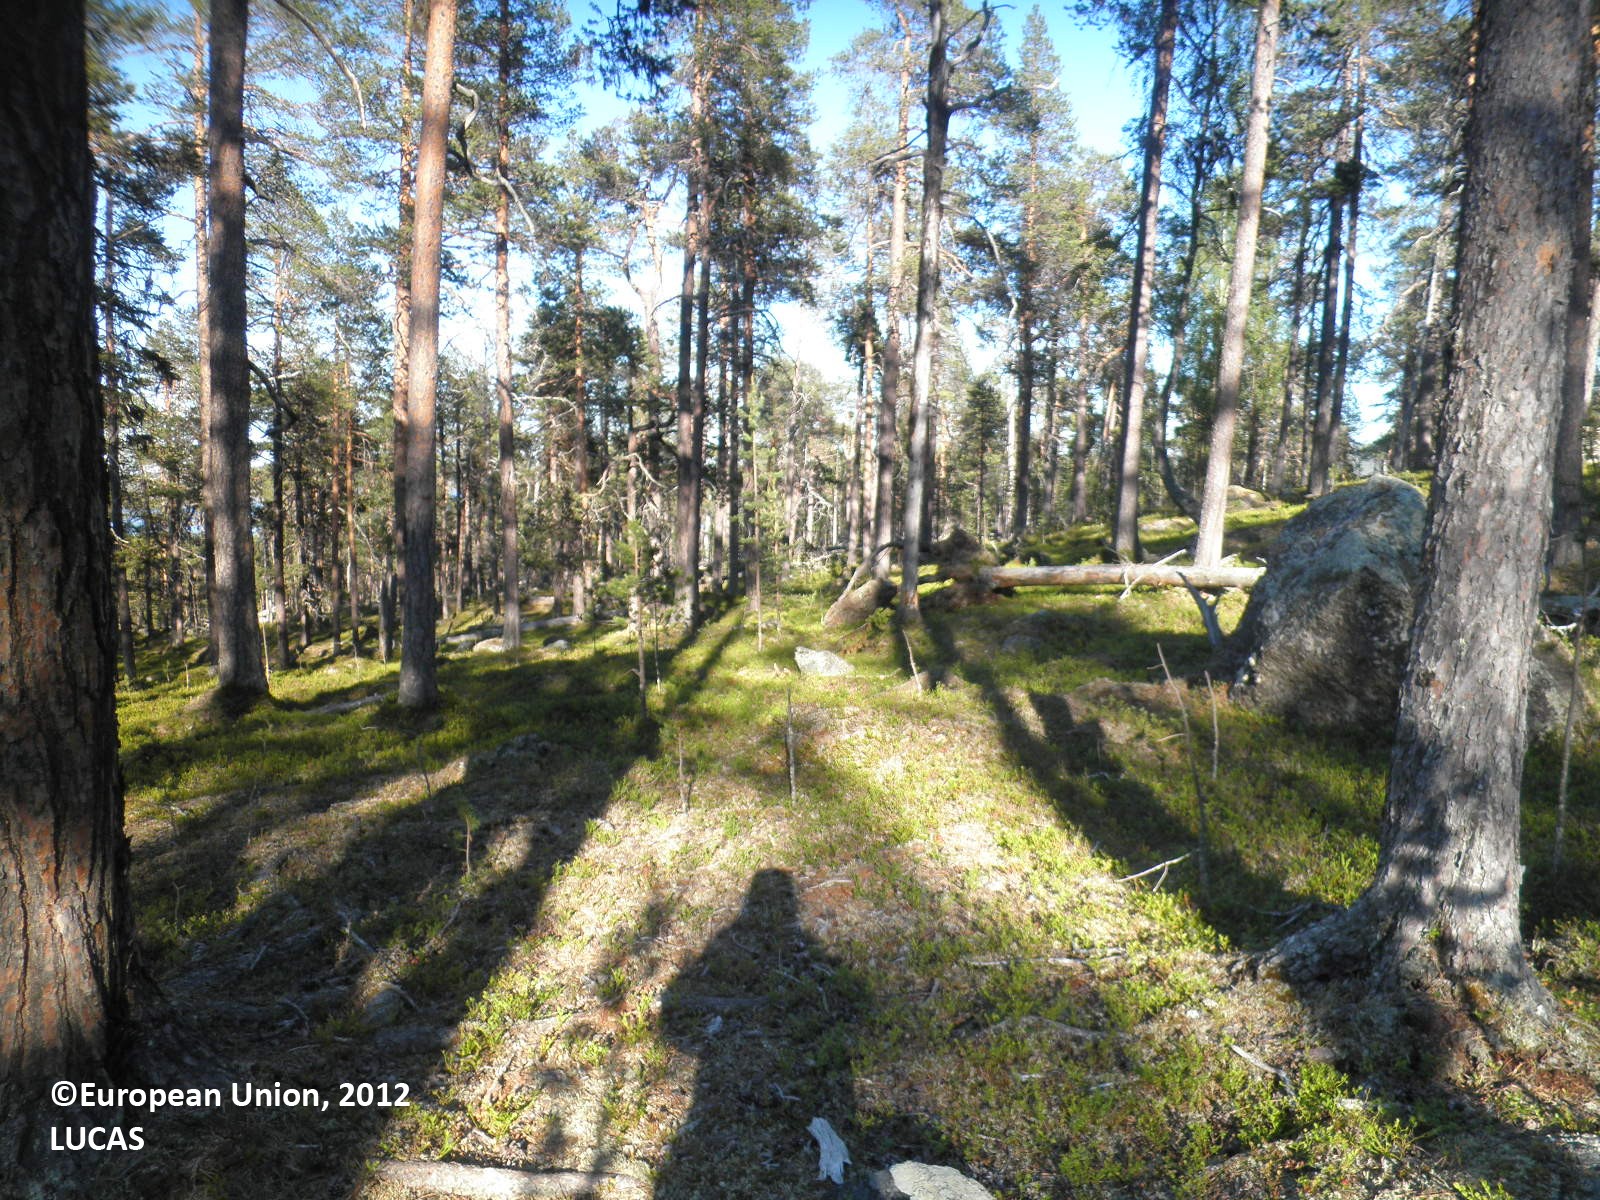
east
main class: Woodland
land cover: Pine dominated coniferous woodland
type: boreal forest
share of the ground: 50 - 75 %
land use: Forestry
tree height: > 5 m
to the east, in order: Pine dominated coniferous woodland; Tracks; Artificial constructions in urban areas; Pine dominated coniferous woodland
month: July
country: FI
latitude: 68.7572
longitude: 27.2568
